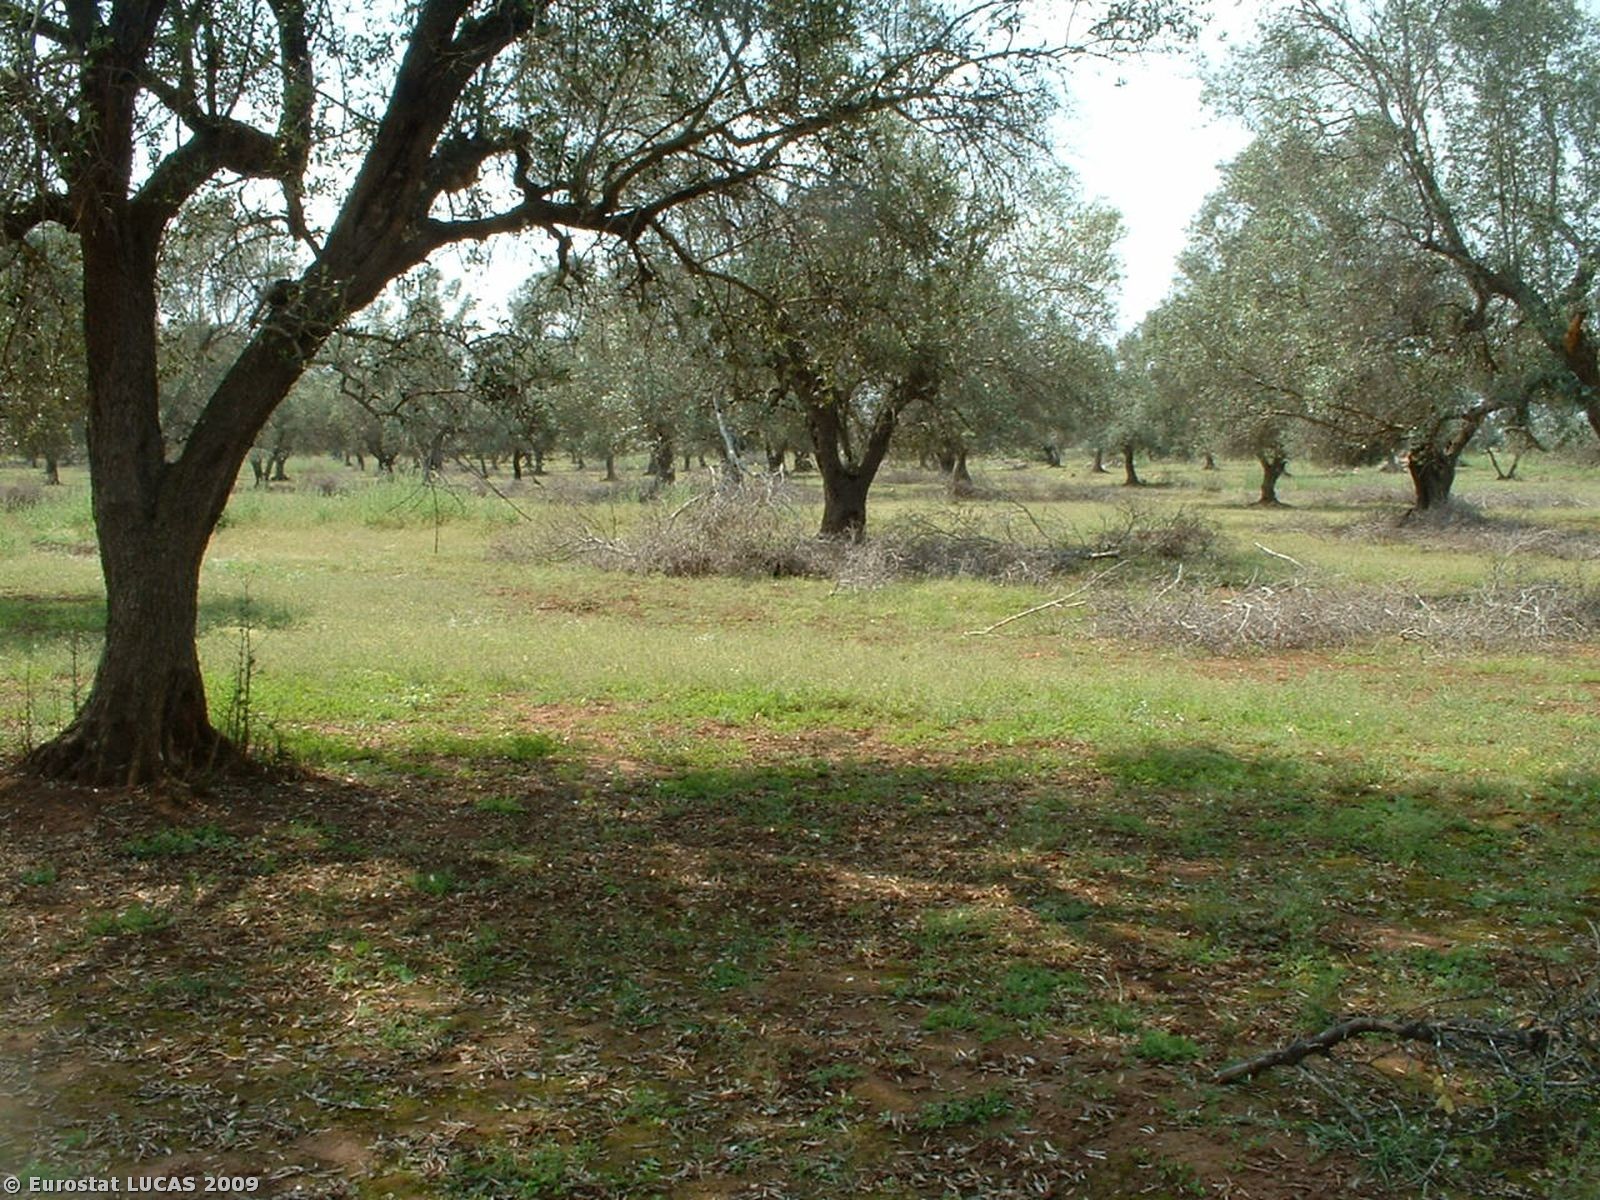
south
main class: Cropland
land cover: Olive groves
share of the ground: 50 - 75 %
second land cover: Bare land
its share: > 75 %
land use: Agriculture (excluding fallow land and kitchen gardens)
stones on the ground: < 10 %
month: May
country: IT
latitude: 40.2213
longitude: 18.1180
